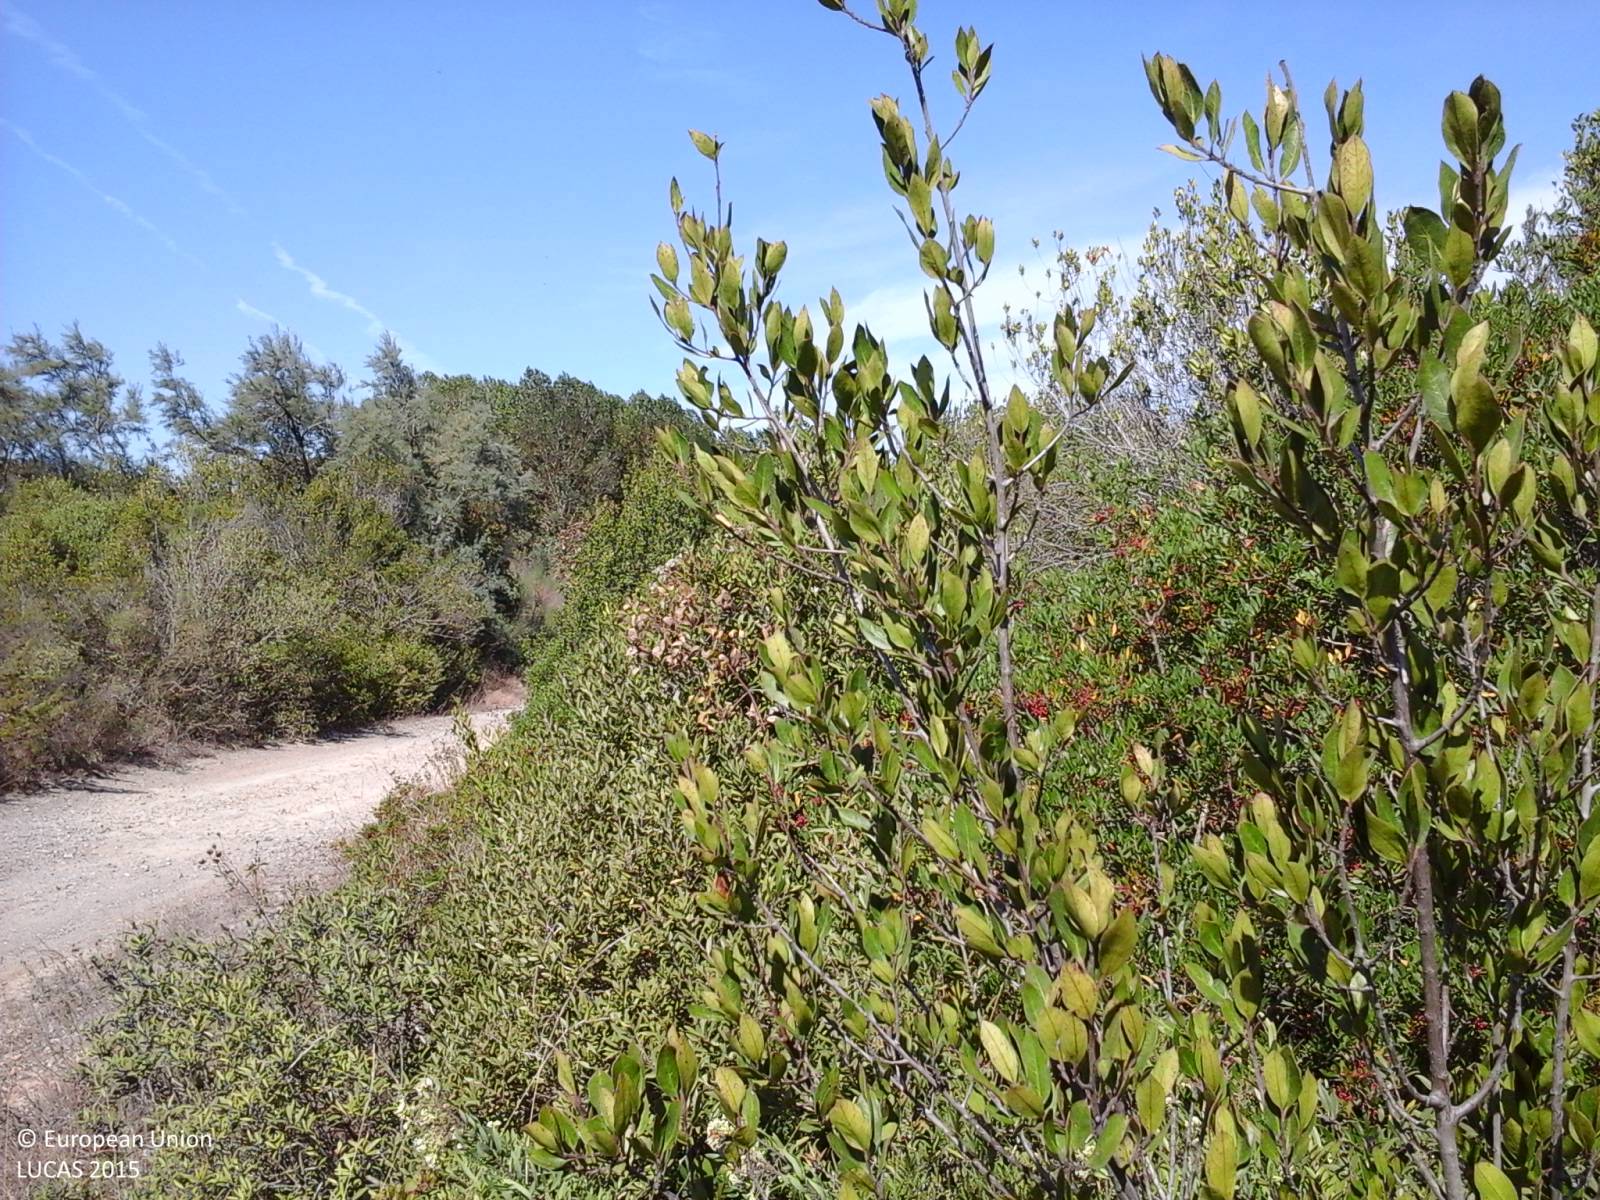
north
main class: Shrubland
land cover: Shrubland with sparse tree cover
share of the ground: > 75 %
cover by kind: shrubs 95 %, broadleaved forest trees 5 %
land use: Semi-natural and natural areas not in use
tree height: < 5 m
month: September
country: IT
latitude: 43.1029
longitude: 10.7227
